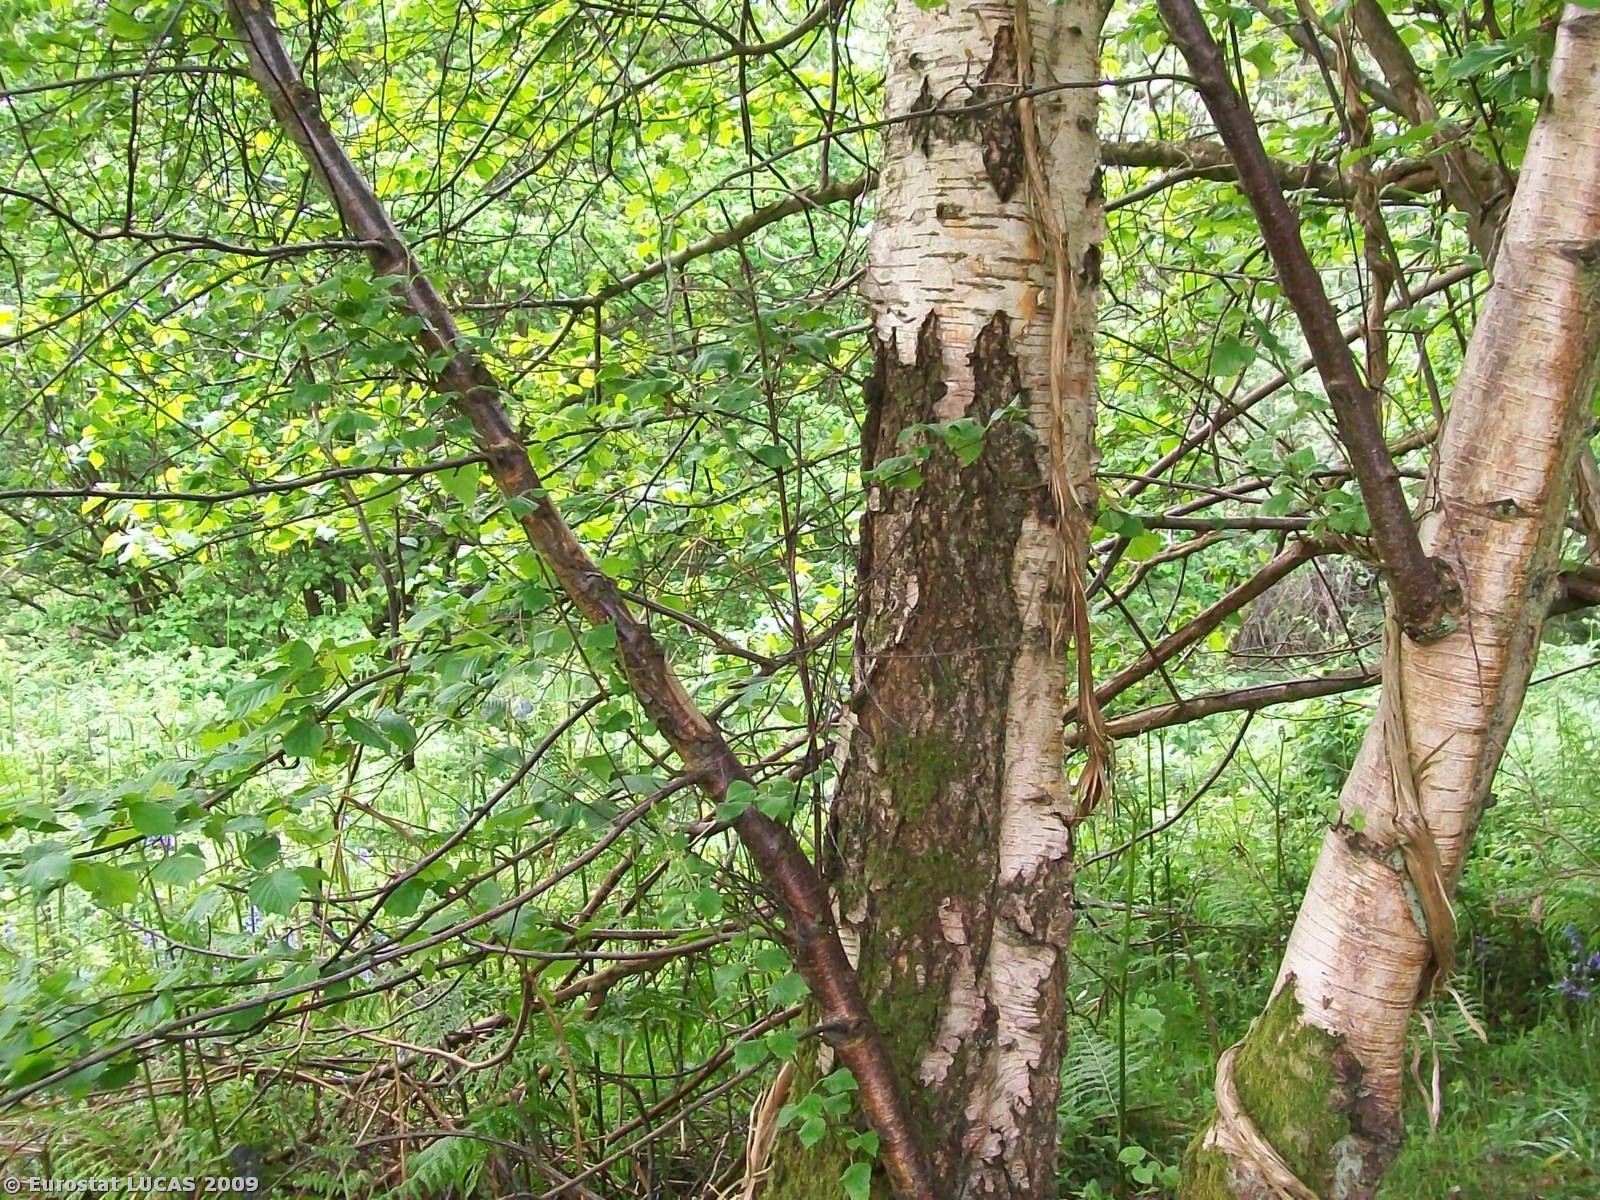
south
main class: Woodland
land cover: Broadleaved woodland
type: mesophytic deciduous forest
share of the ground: > 75 %
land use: Unused
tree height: > 5 m
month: May
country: GB
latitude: 51.0245
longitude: -2.1363
